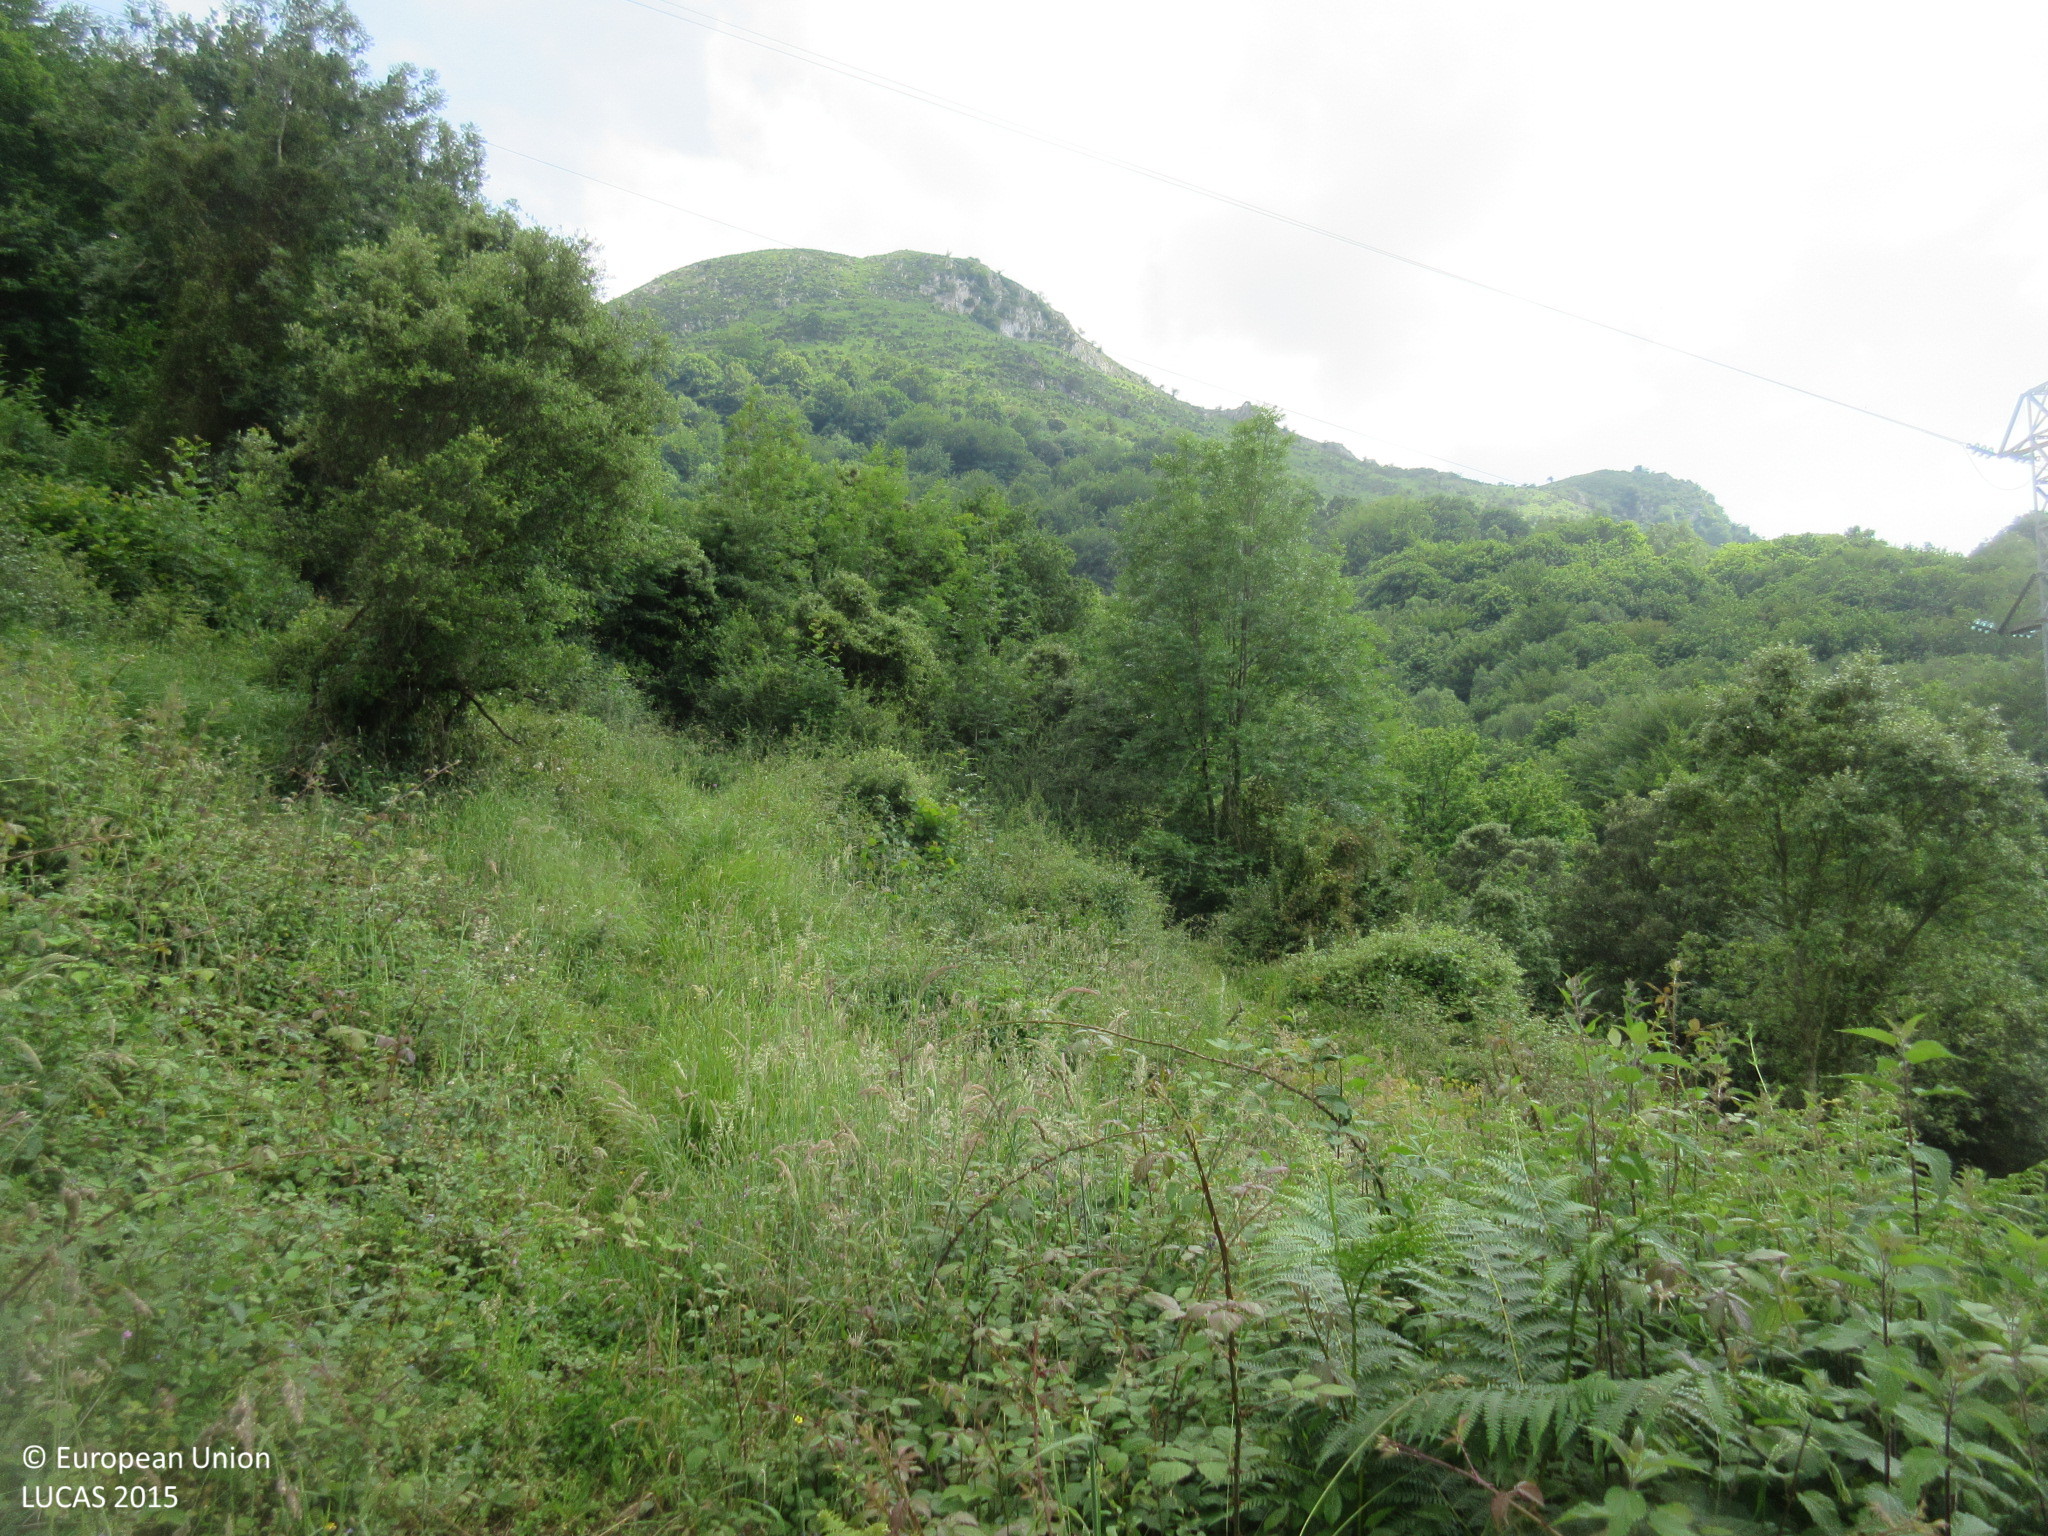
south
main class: Shrubland
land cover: Shrubland without tree cover
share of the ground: > 75 %
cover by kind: shrubs 90 %, herbaceous plants 10 %
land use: Agriculture (excluding fallow land and kitchen gardens)
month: June
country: ES
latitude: 43.2868
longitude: -5.9756
